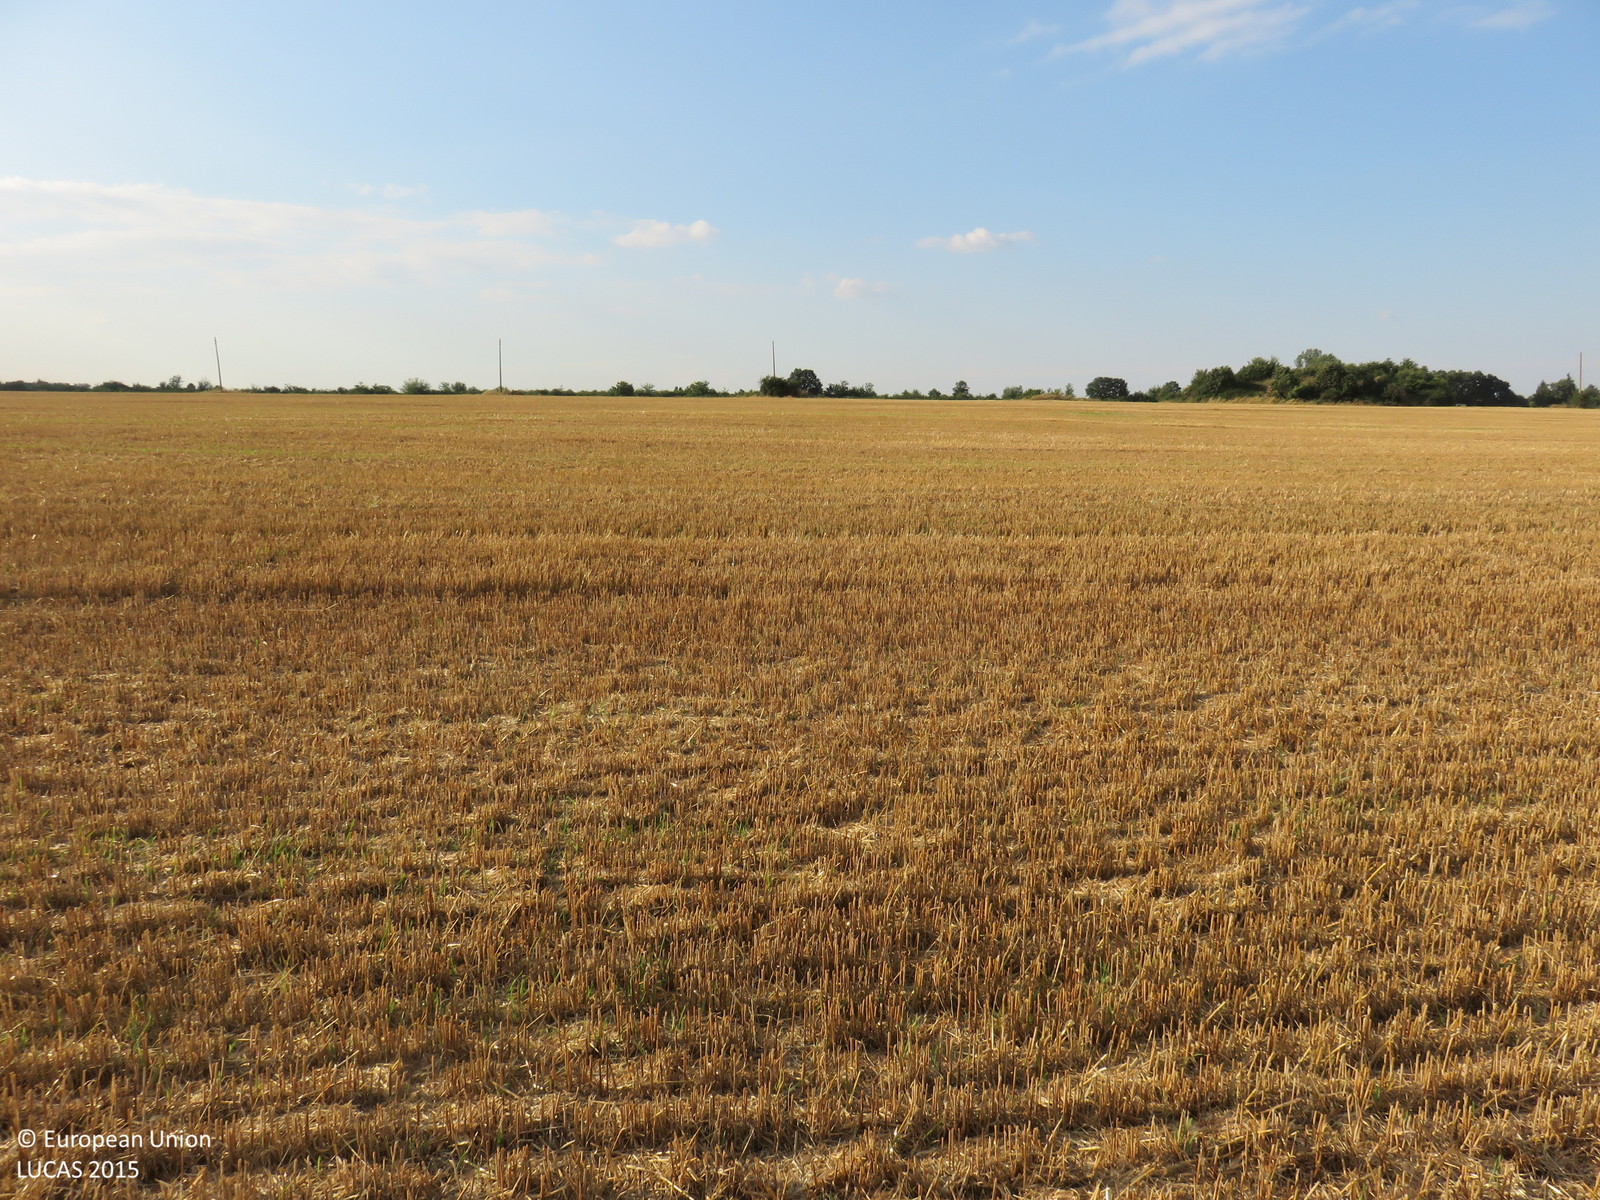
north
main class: Cropland
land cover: Barley
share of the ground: > 75 %
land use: Agriculture (excluding fallow land and kitchen gardens)
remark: Harvested field
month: June
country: BG
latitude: 43.3221
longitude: 25.0278
